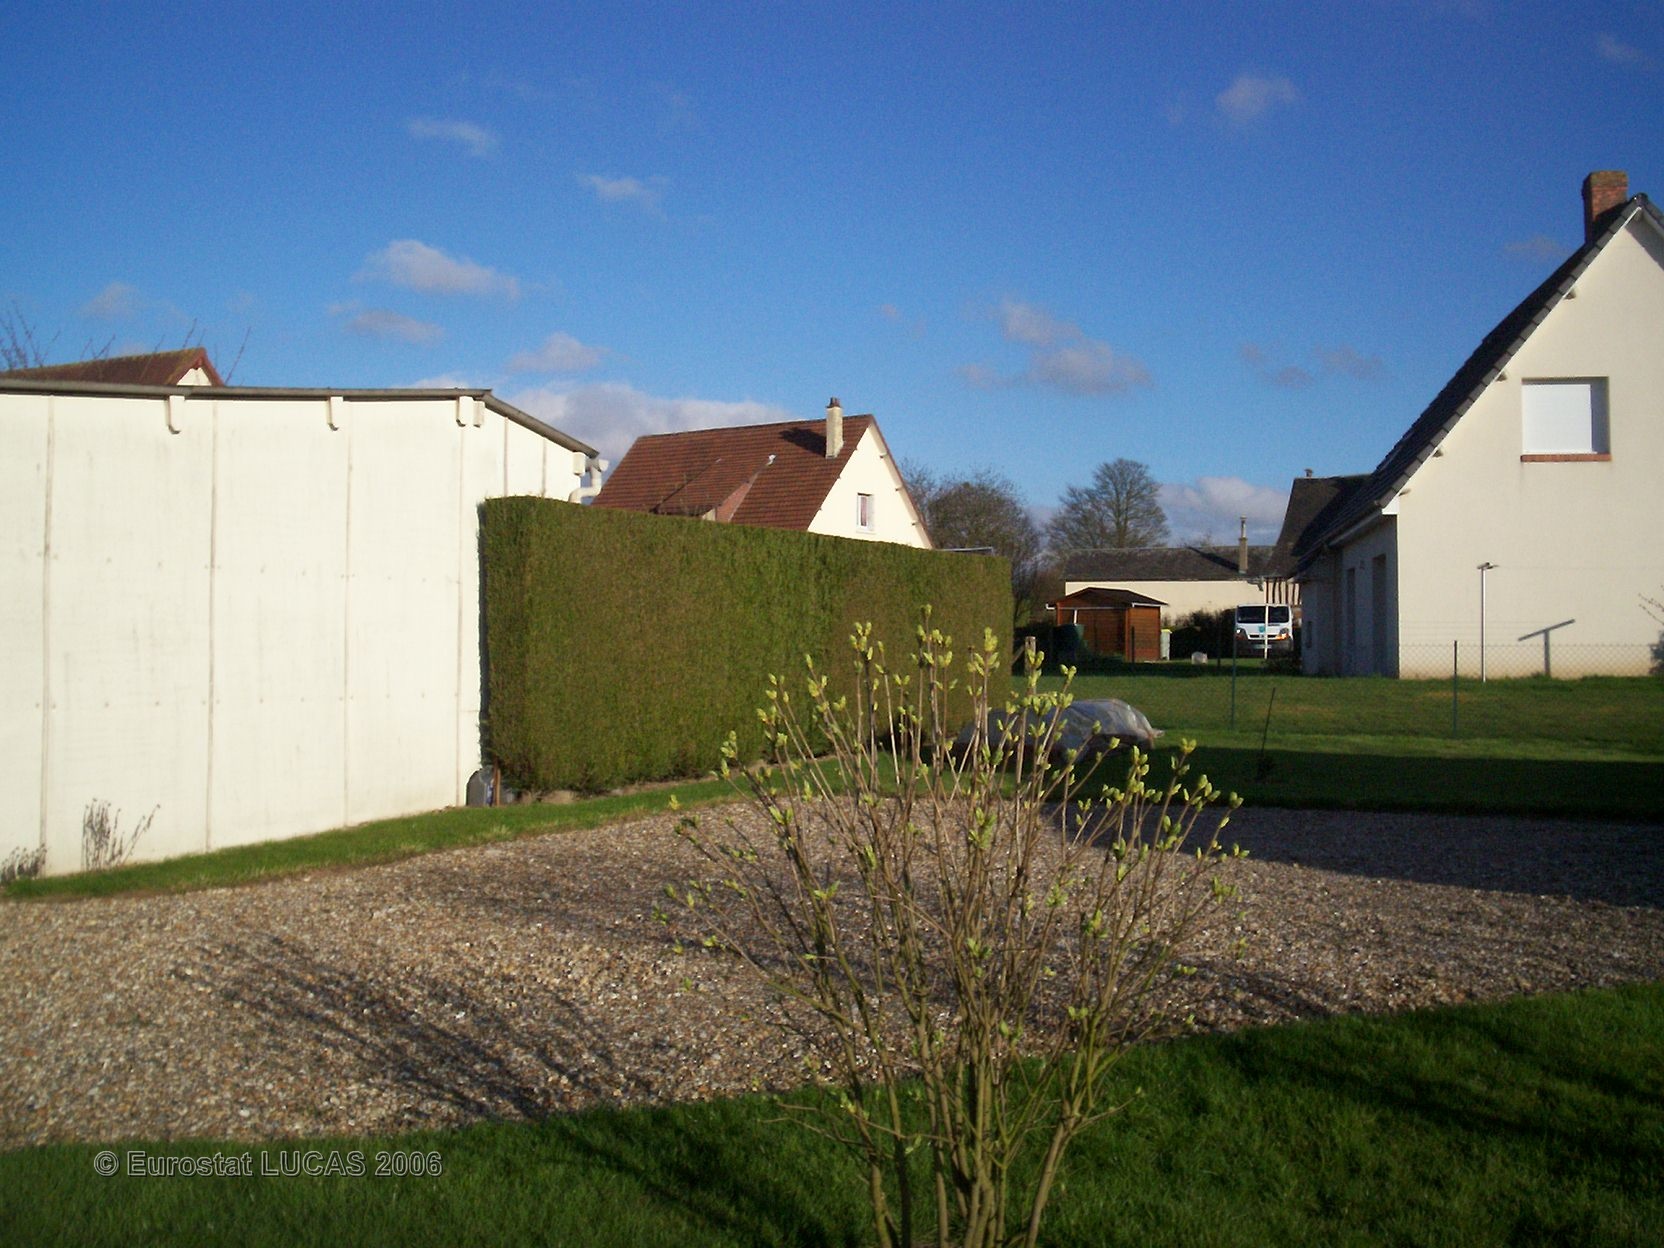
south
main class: Grassland
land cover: Grassland without tree/shrub cover
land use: Residential
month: April
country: FR
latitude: 49.5345
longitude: 0.9543
